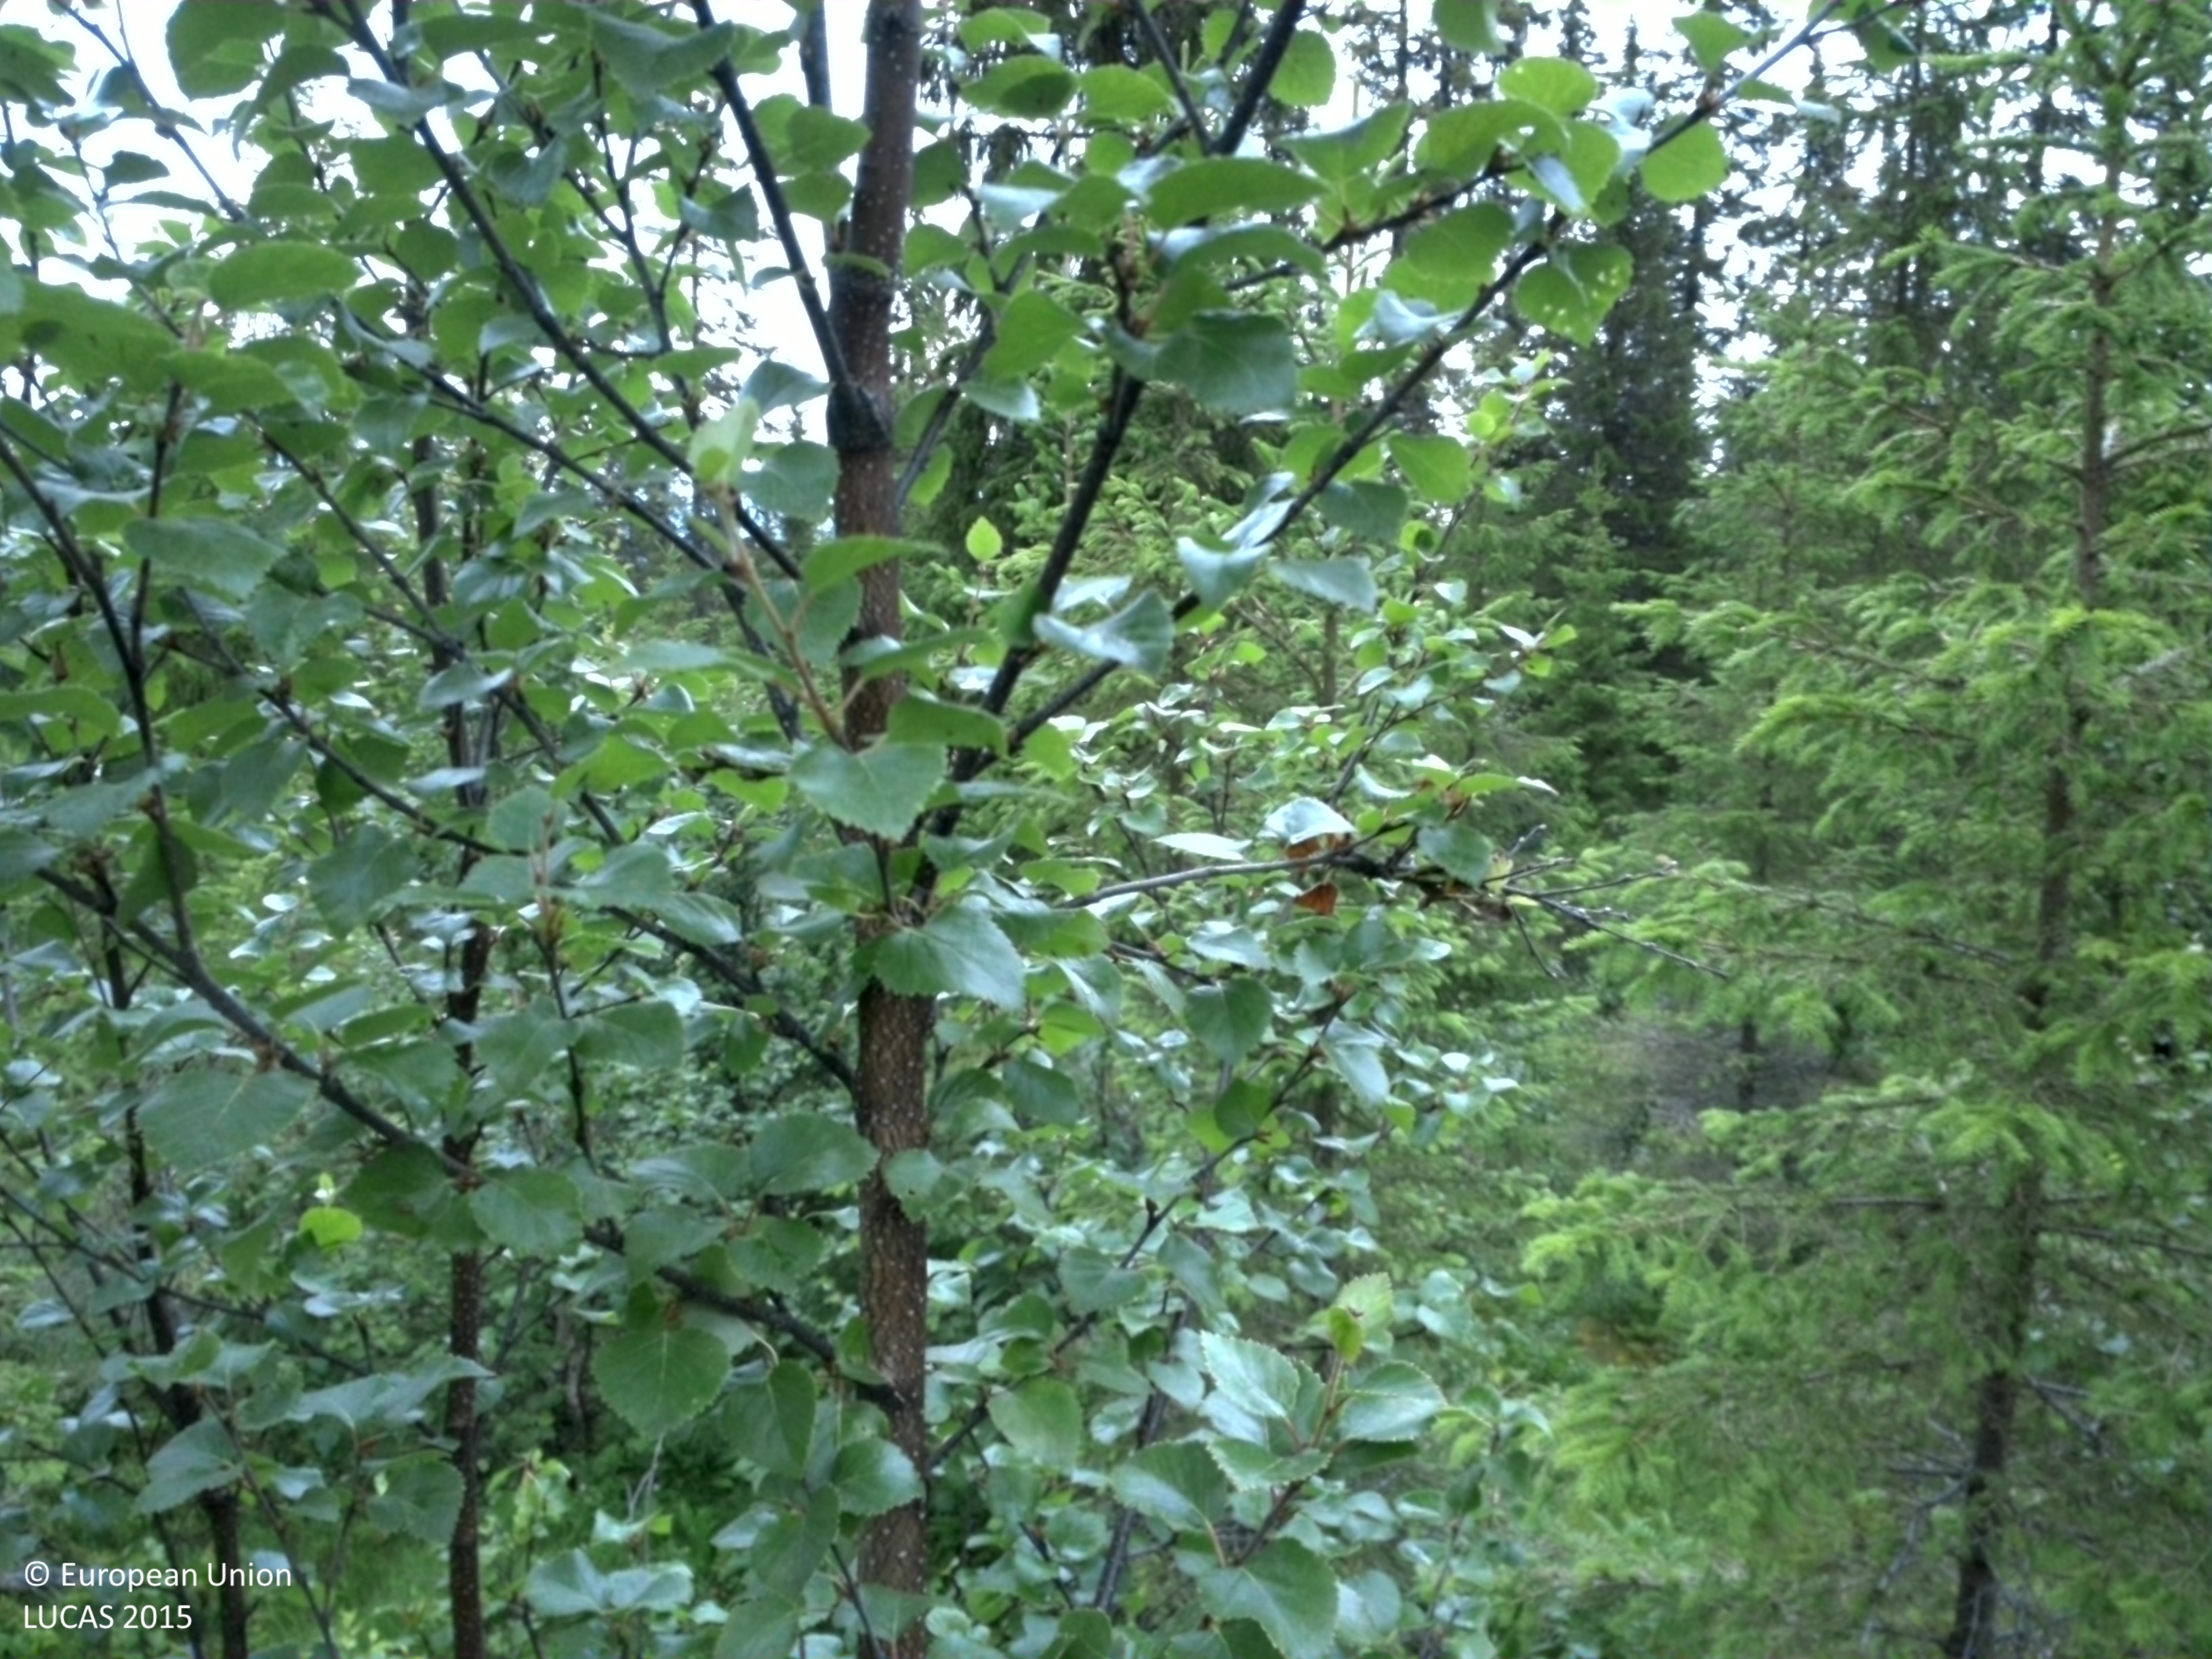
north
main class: Woodland
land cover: Spruce dominated mixed woodland
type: boreal forest
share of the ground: 25 - 50 %
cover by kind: herbaceous plants 30 %, coniferous forest trees 25 %, shrubs 25 %, broadleaved forest trees 10 %, lichens and mosses 10 %
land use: Forestry
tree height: < 5 m
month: August
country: SE
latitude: 64.9715
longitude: 15.5389
